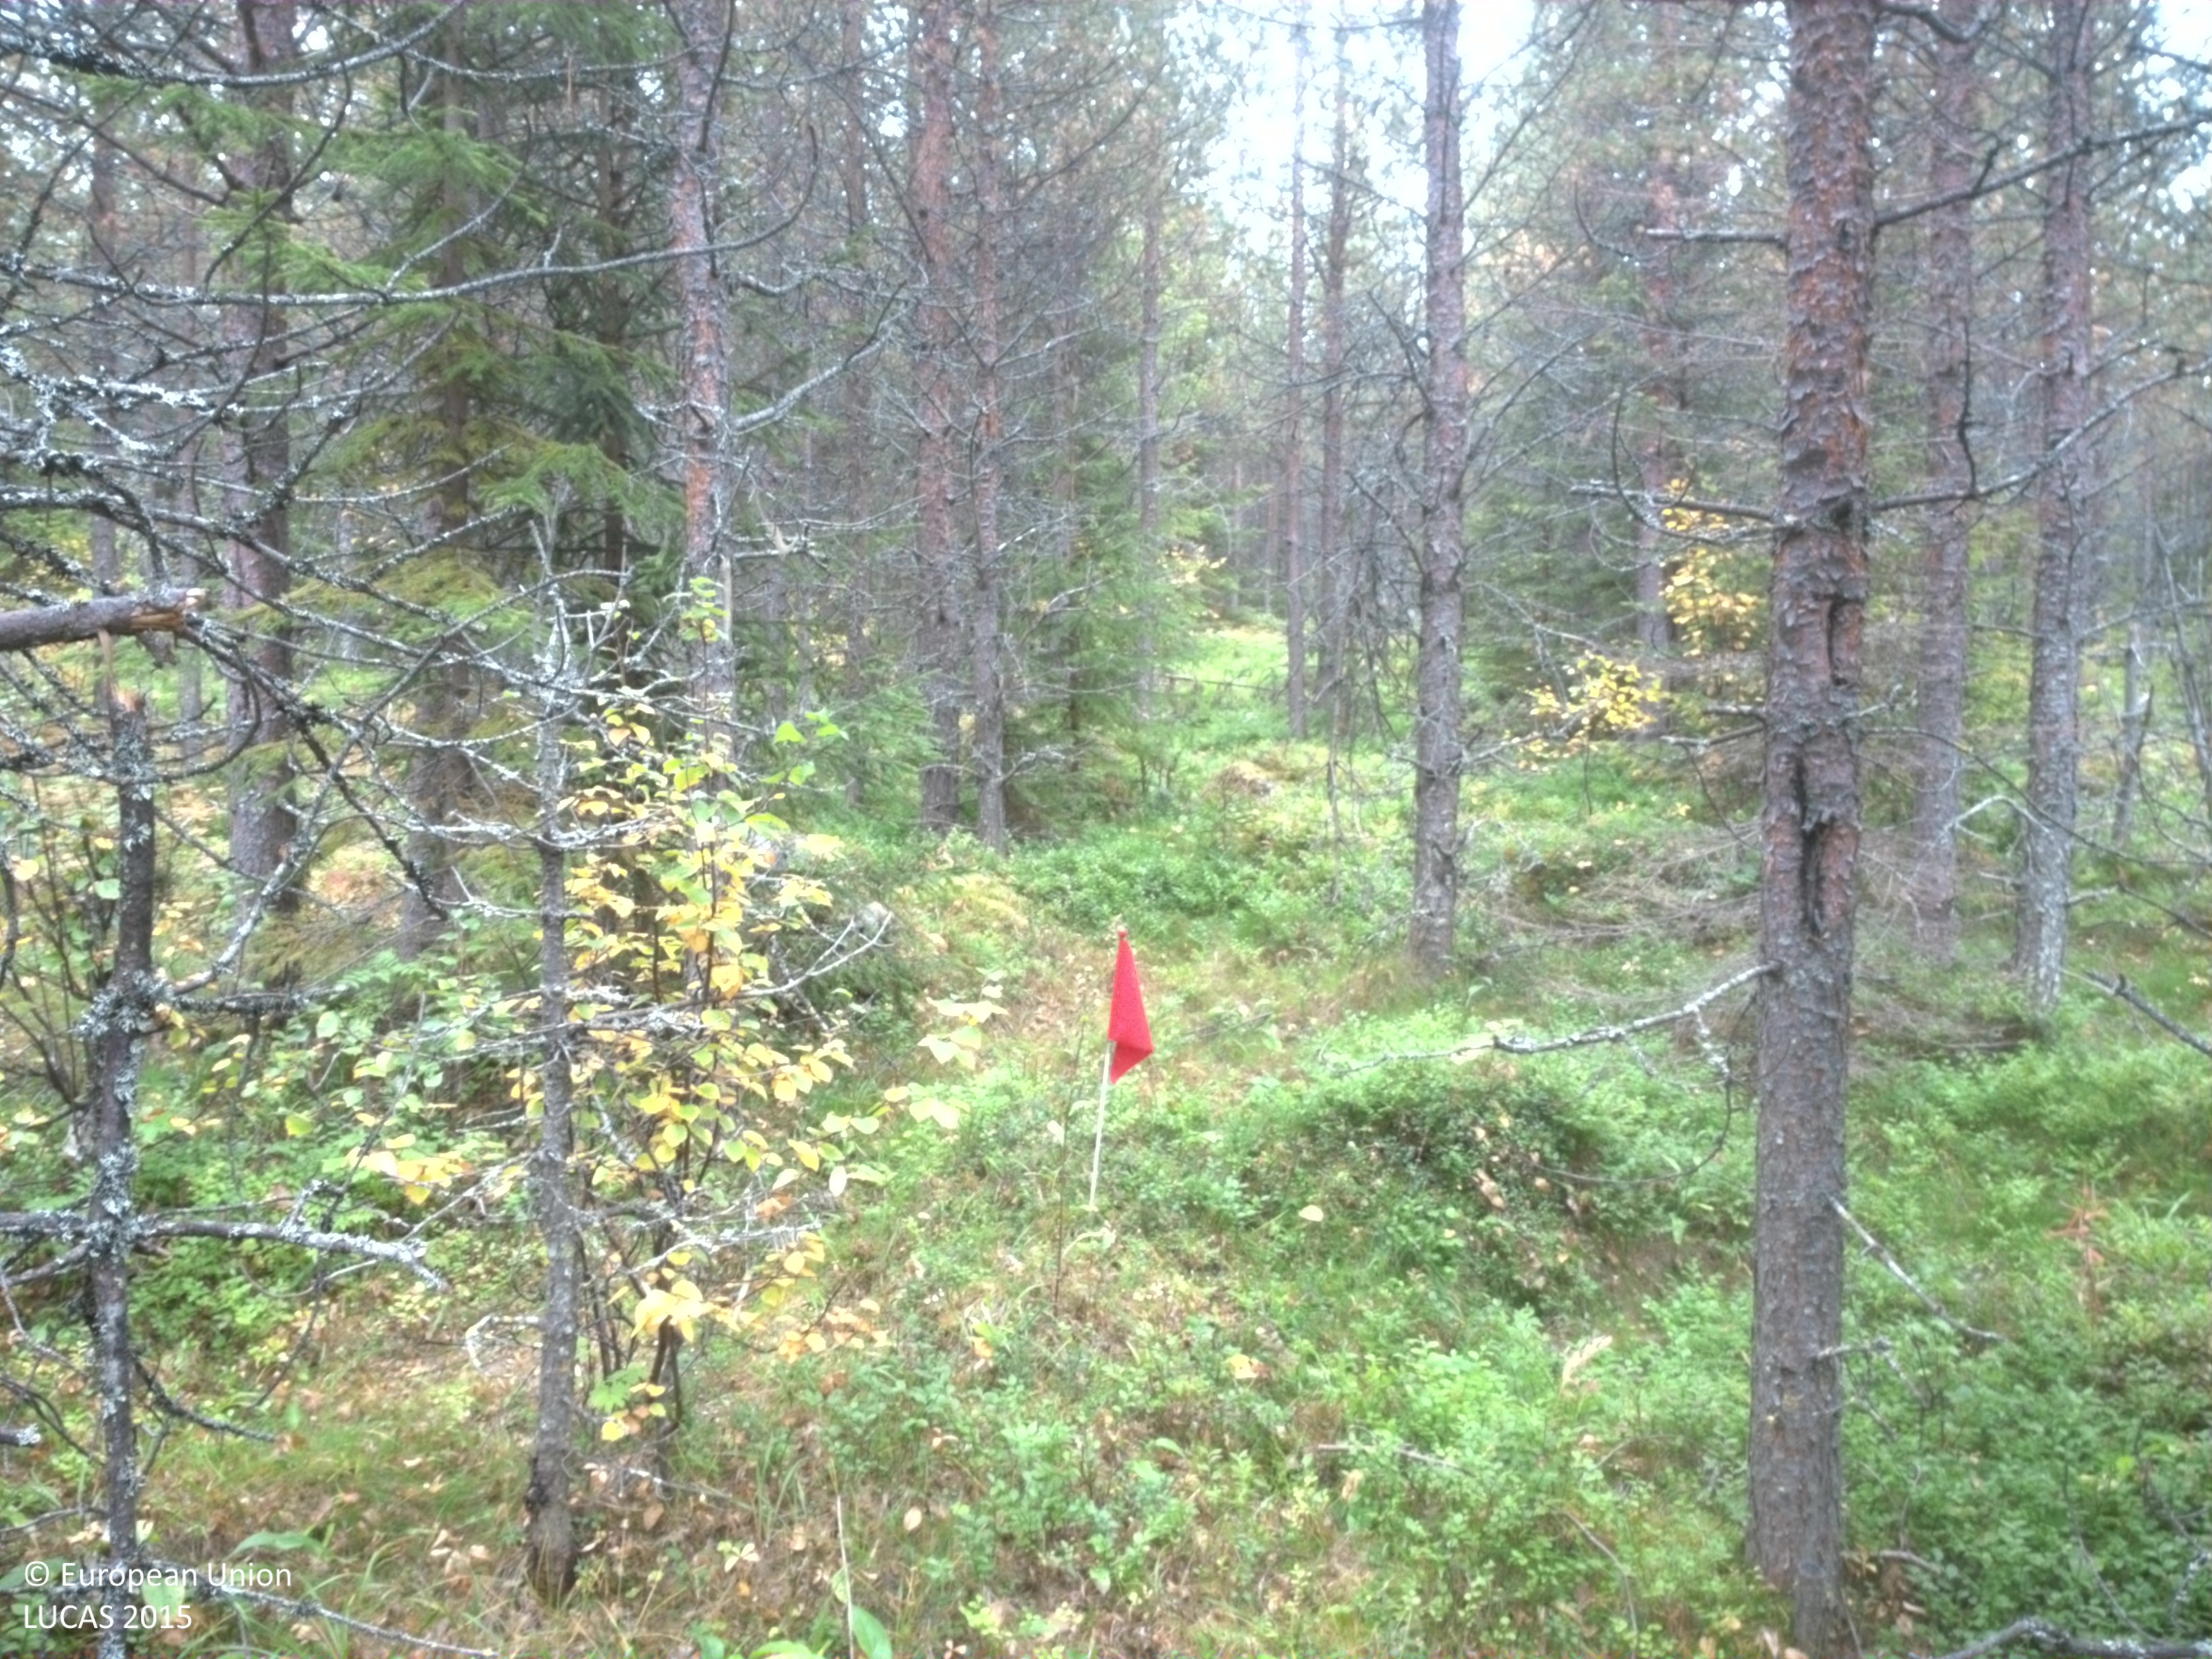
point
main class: Woodland
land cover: Pine dominated coniferous woodland
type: boreal forest
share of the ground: 50 - 75 %
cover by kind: coniferous forest trees 60 %, shrubs 20 %, herbaceous plants 10 %, broadleaved forest trees 5 %, lichens and mosses 5 %
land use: Forestry
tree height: > 5 m
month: September
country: SE
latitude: 64.4302
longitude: 20.2552
